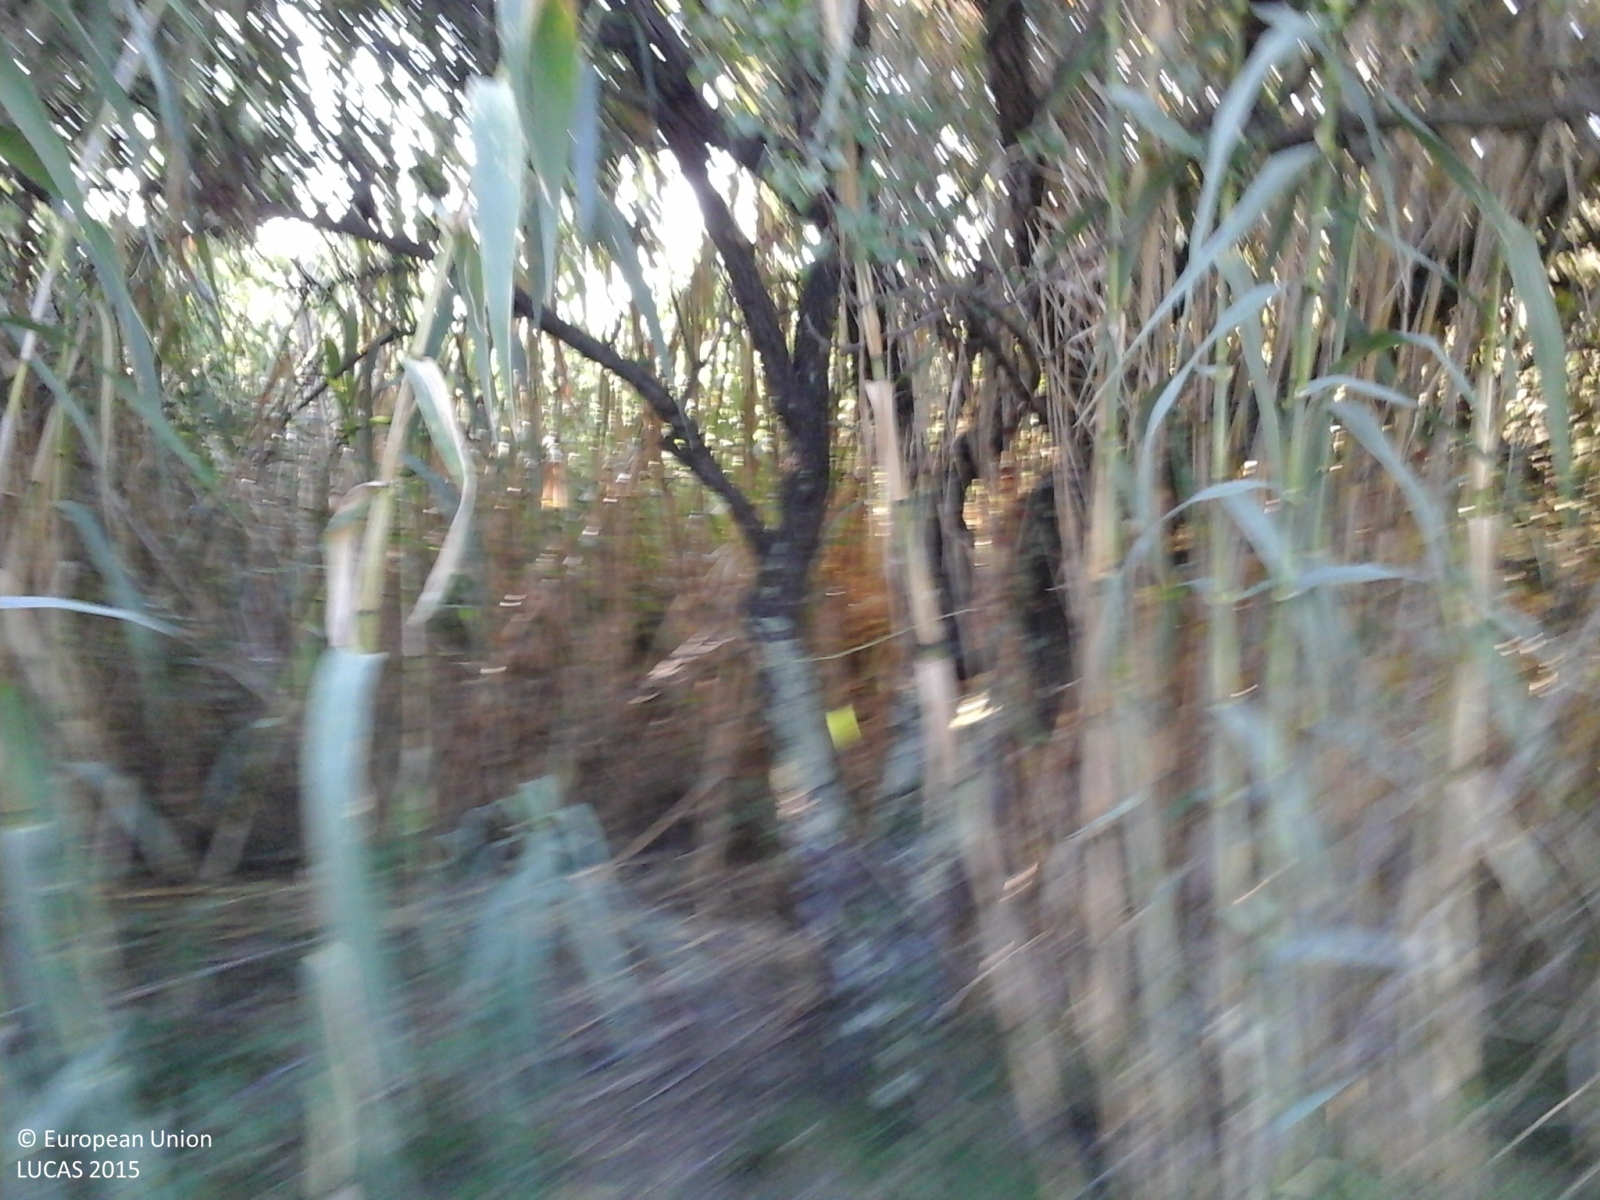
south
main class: Grassland
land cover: Grassland with sparse tree/shrub cover
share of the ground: > 75 %
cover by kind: herbaceous plants 80 %, shrubs 10 %, broadleaved forest trees 5 %, lichens and mosses 5 %
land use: Agriculture (excluding fallow land and kitchen gardens)
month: September
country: IT
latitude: 44.3936
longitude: 8.4843
